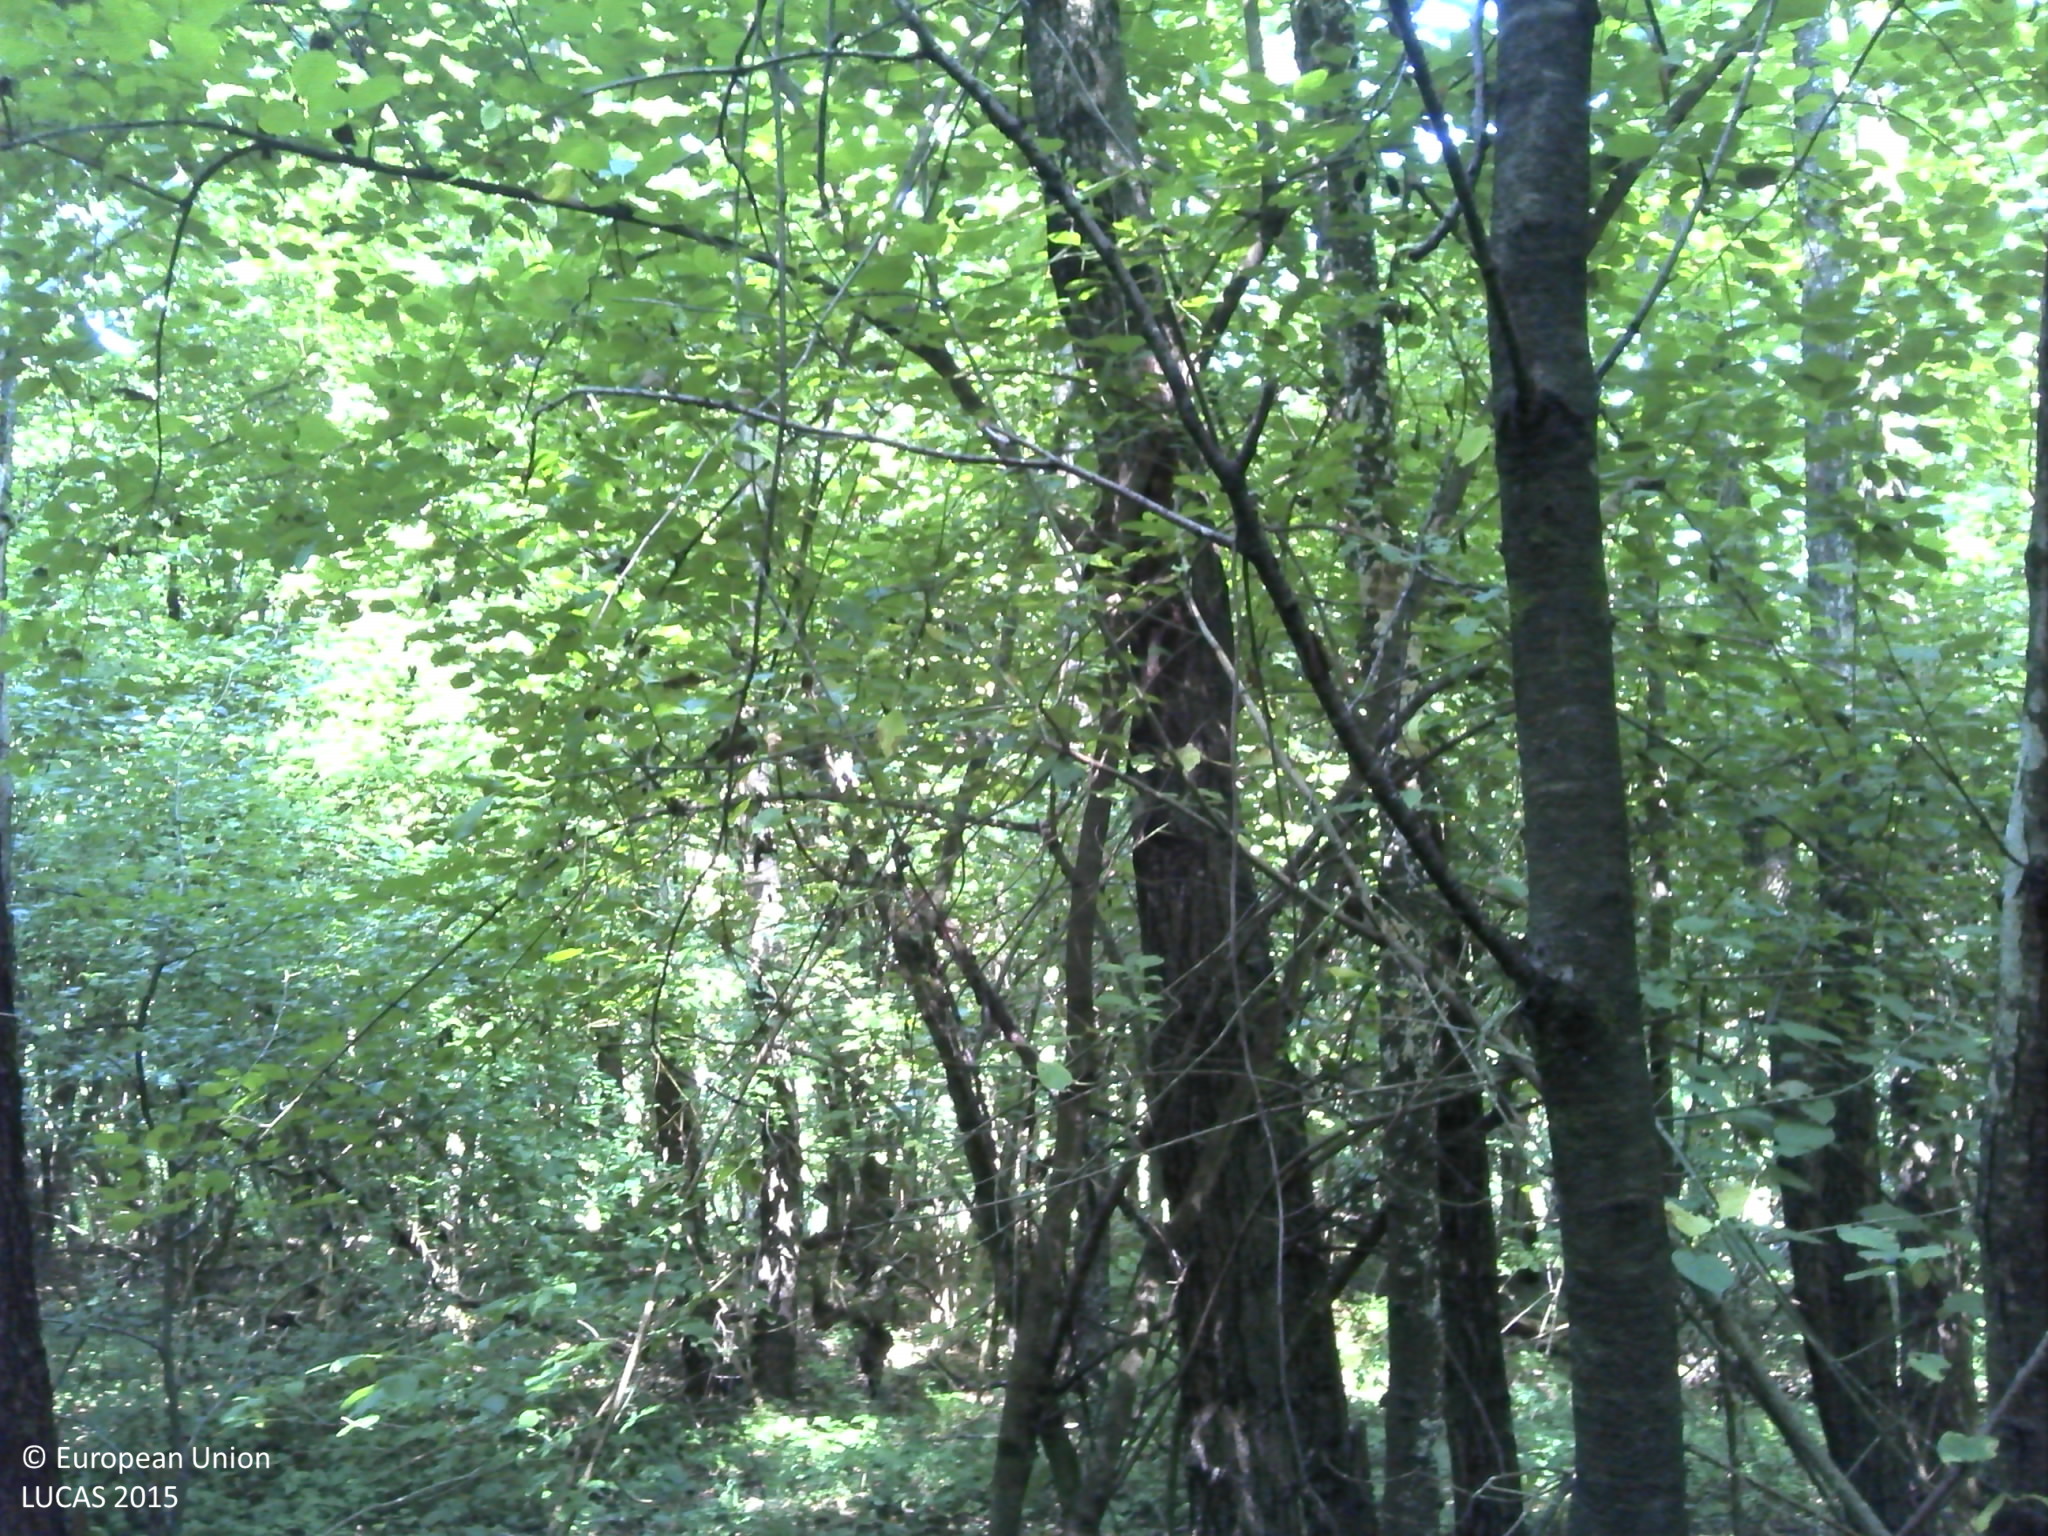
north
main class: Woodland
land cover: Broadleaved woodland
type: thermophilous deciduous forest
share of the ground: > 75 %
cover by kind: broadleaved forest trees 100 %
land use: Forestry
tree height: > 5 m
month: August
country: HR
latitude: 45.3310
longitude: 15.7251
